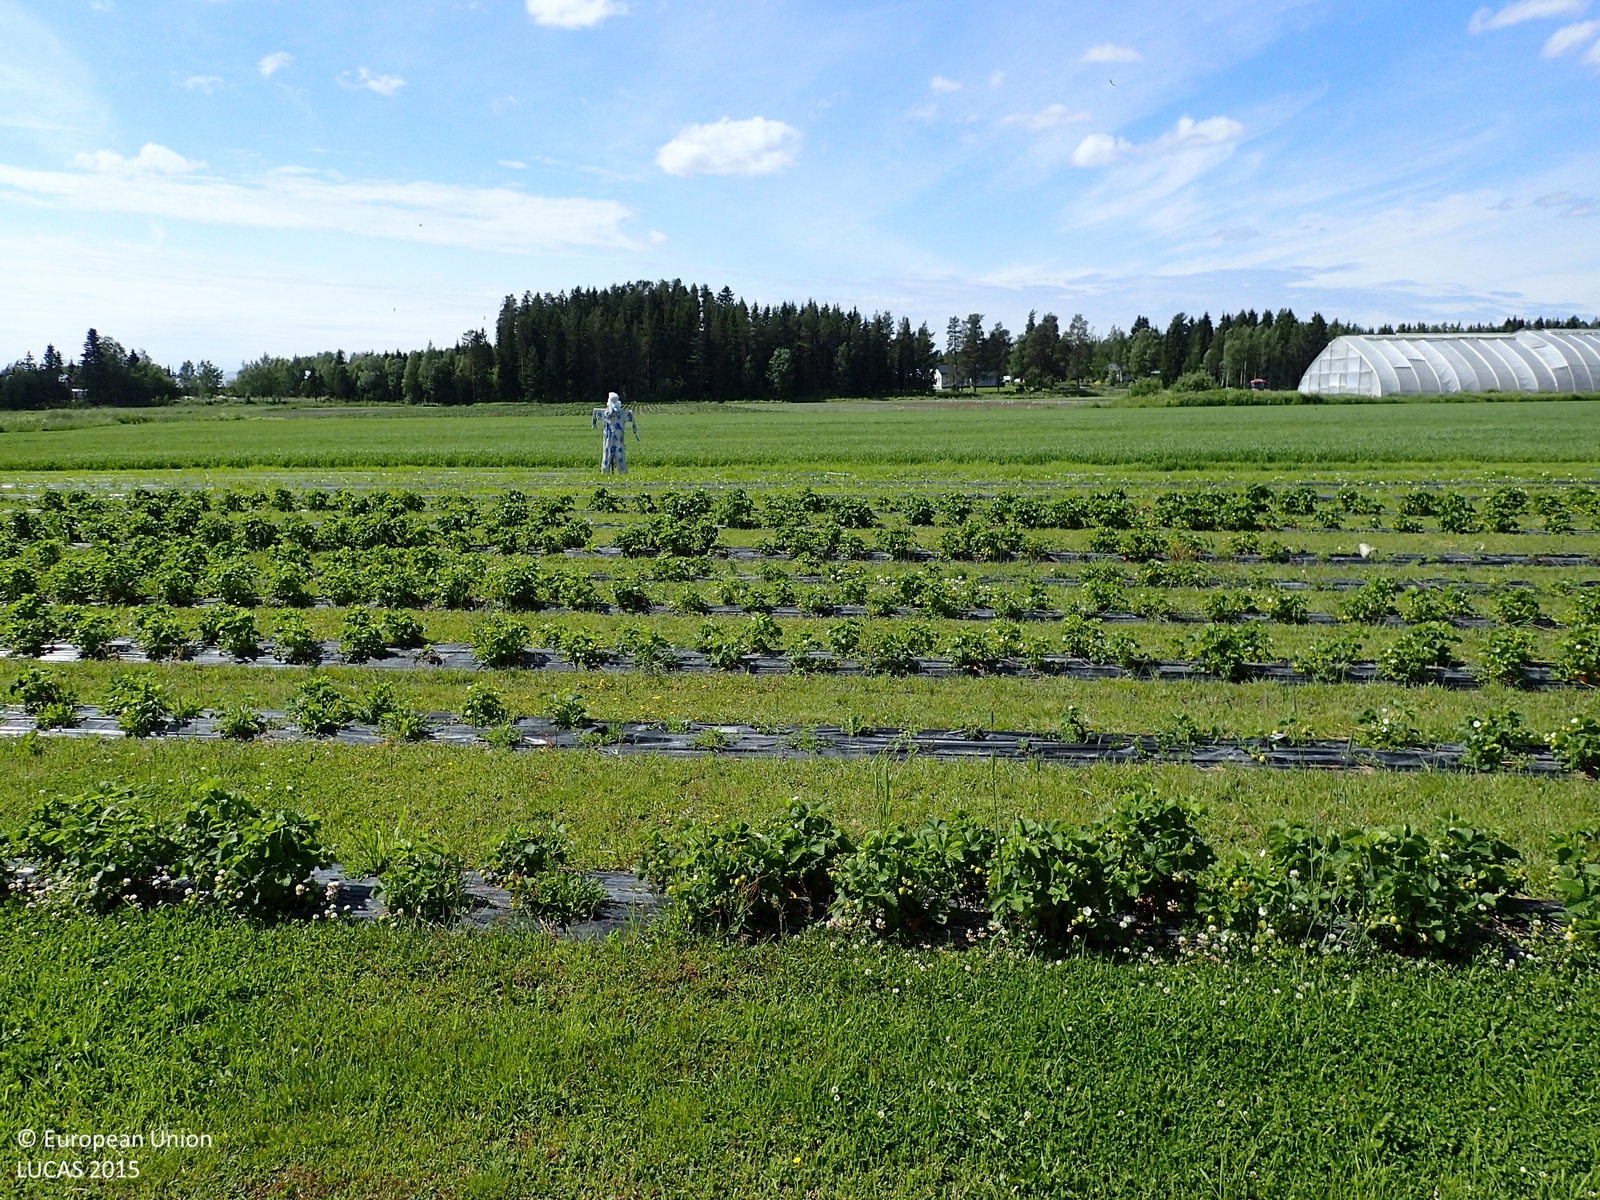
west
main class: Cropland
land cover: Strawberries
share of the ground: 50 - 75 %
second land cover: Temporary grasslands
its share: 50 - 75 %
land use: Agriculture (excluding fallow land and kitchen gardens)
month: July
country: FI
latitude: 62.8346
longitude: 21.4072
